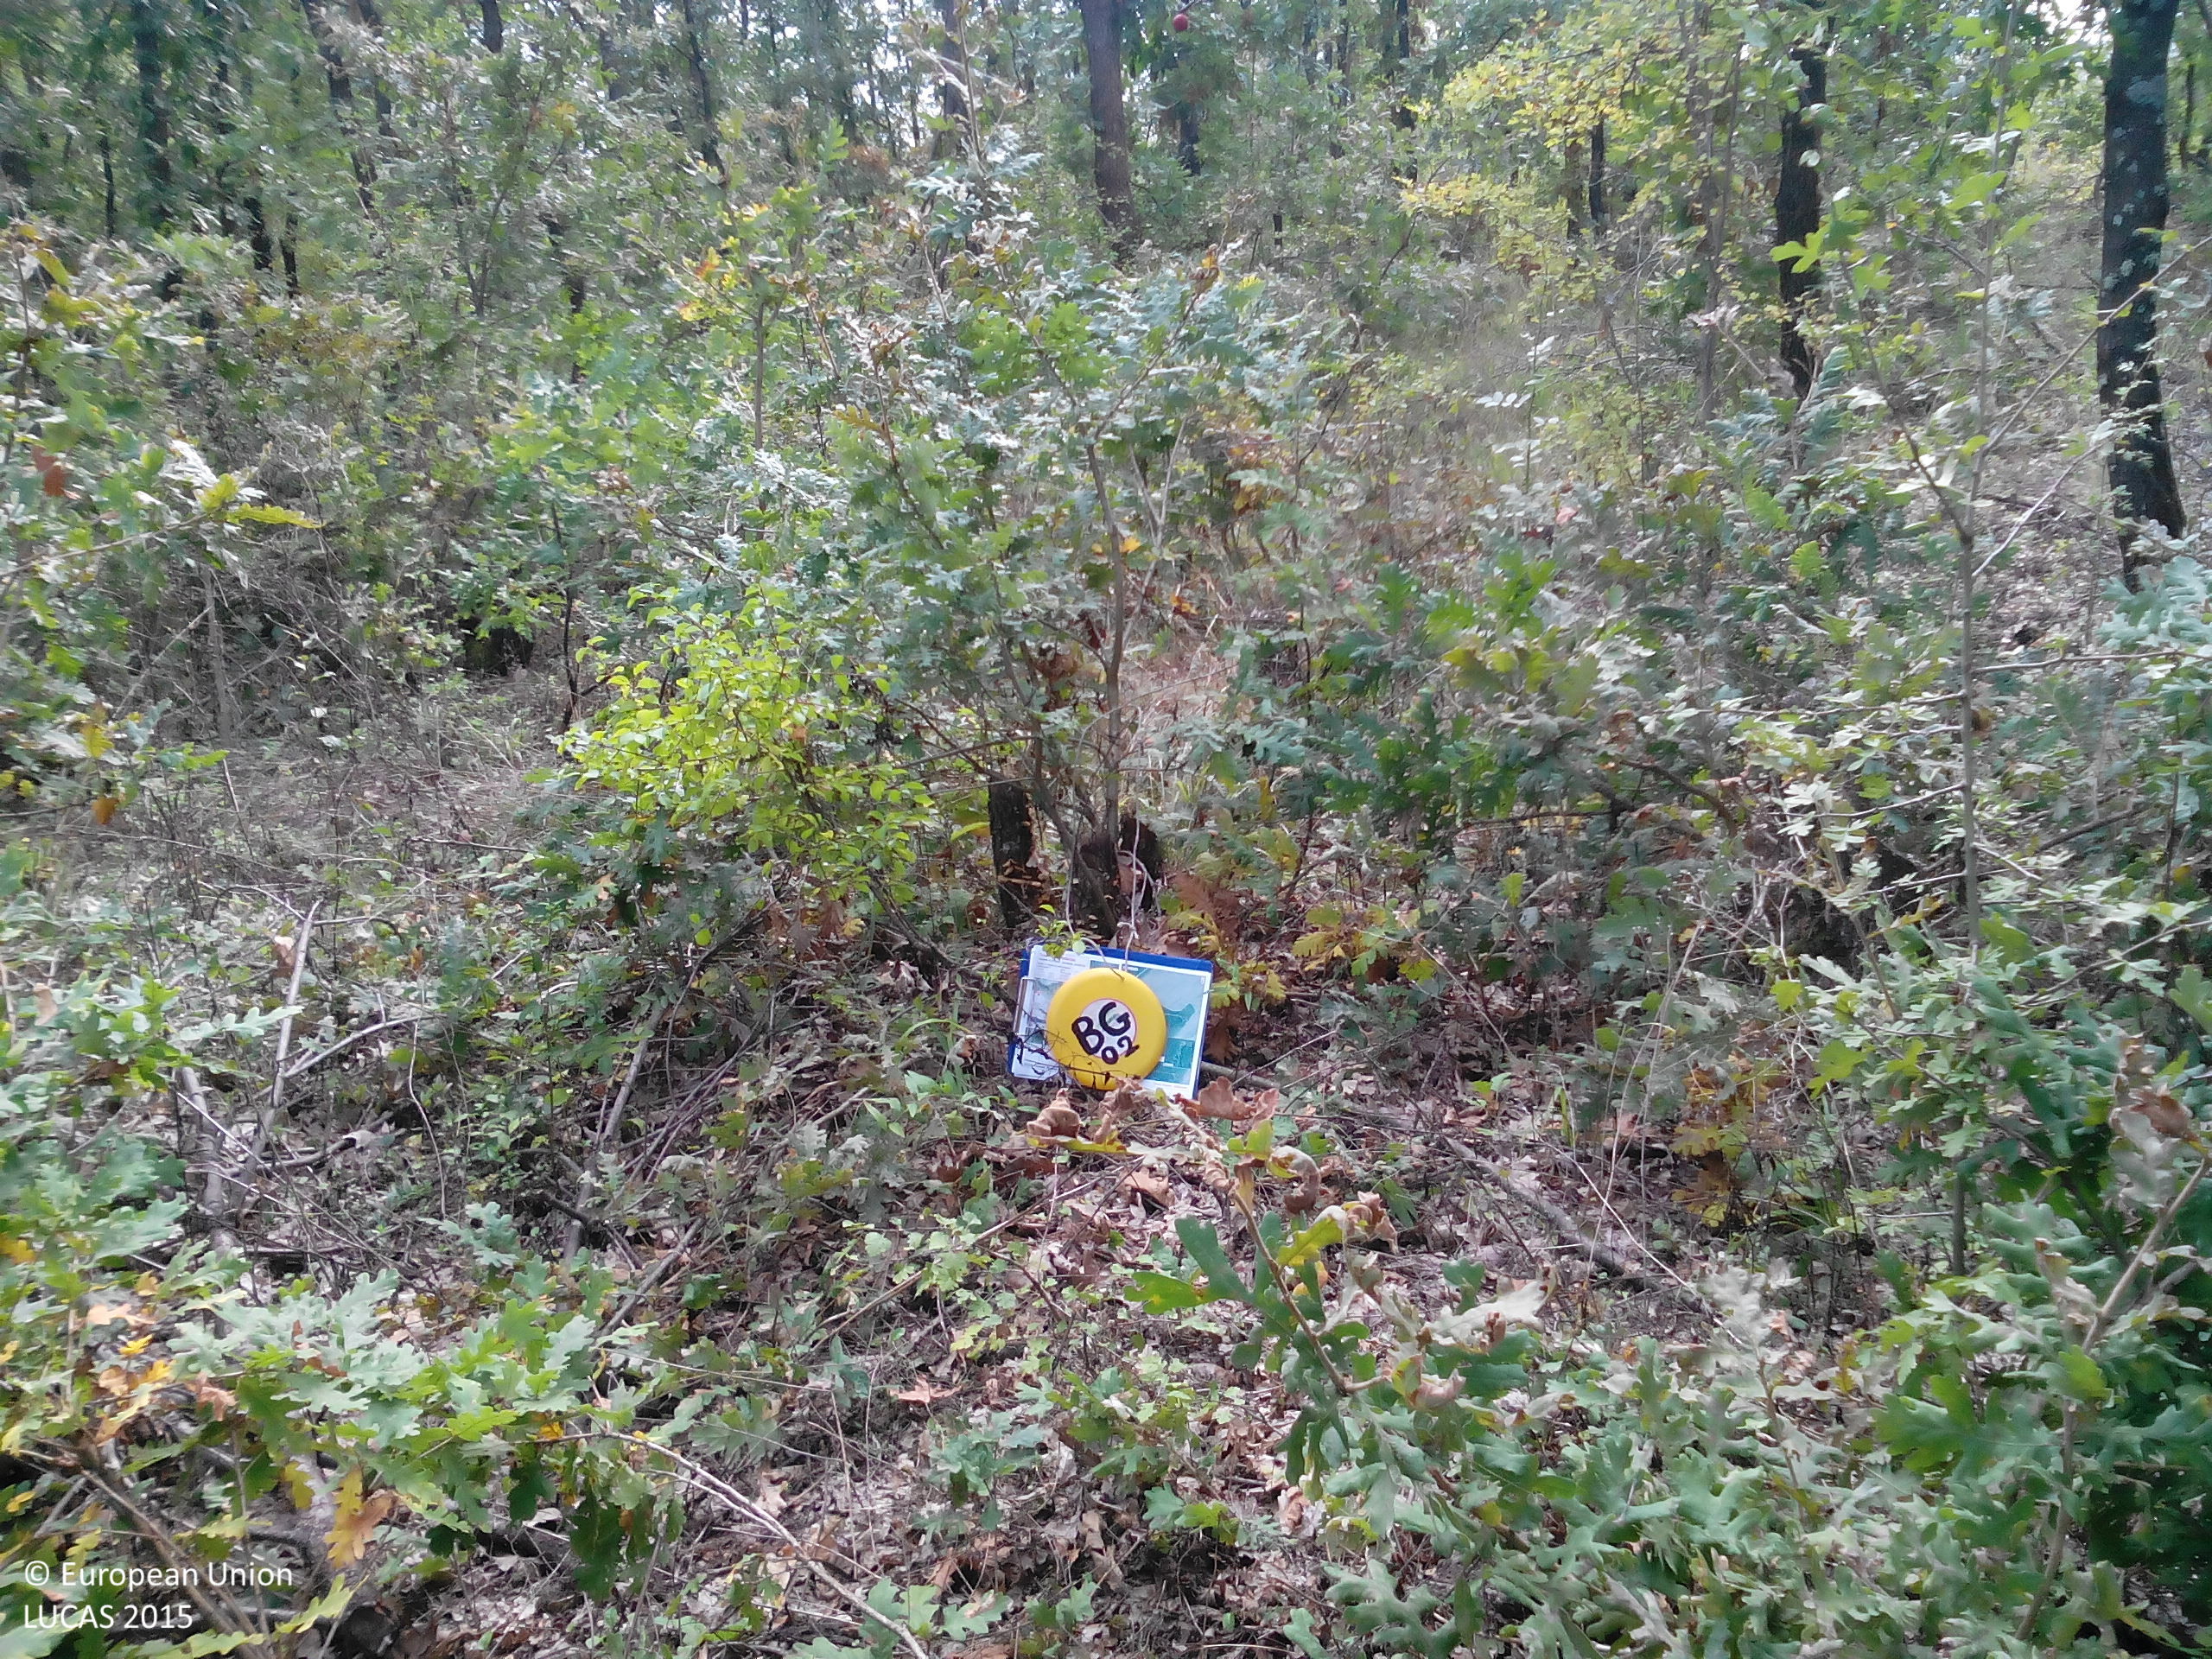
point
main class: Woodland
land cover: Broadleaved woodland
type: acidophilous oak and oak-birch forest
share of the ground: > 75 %
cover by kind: broadleaved forest trees 75 %, shrubs 15 %, herbaceous plants 10 %
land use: Forestry
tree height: > 5 m
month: October
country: BG
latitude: 43.2103
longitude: 24.0208
